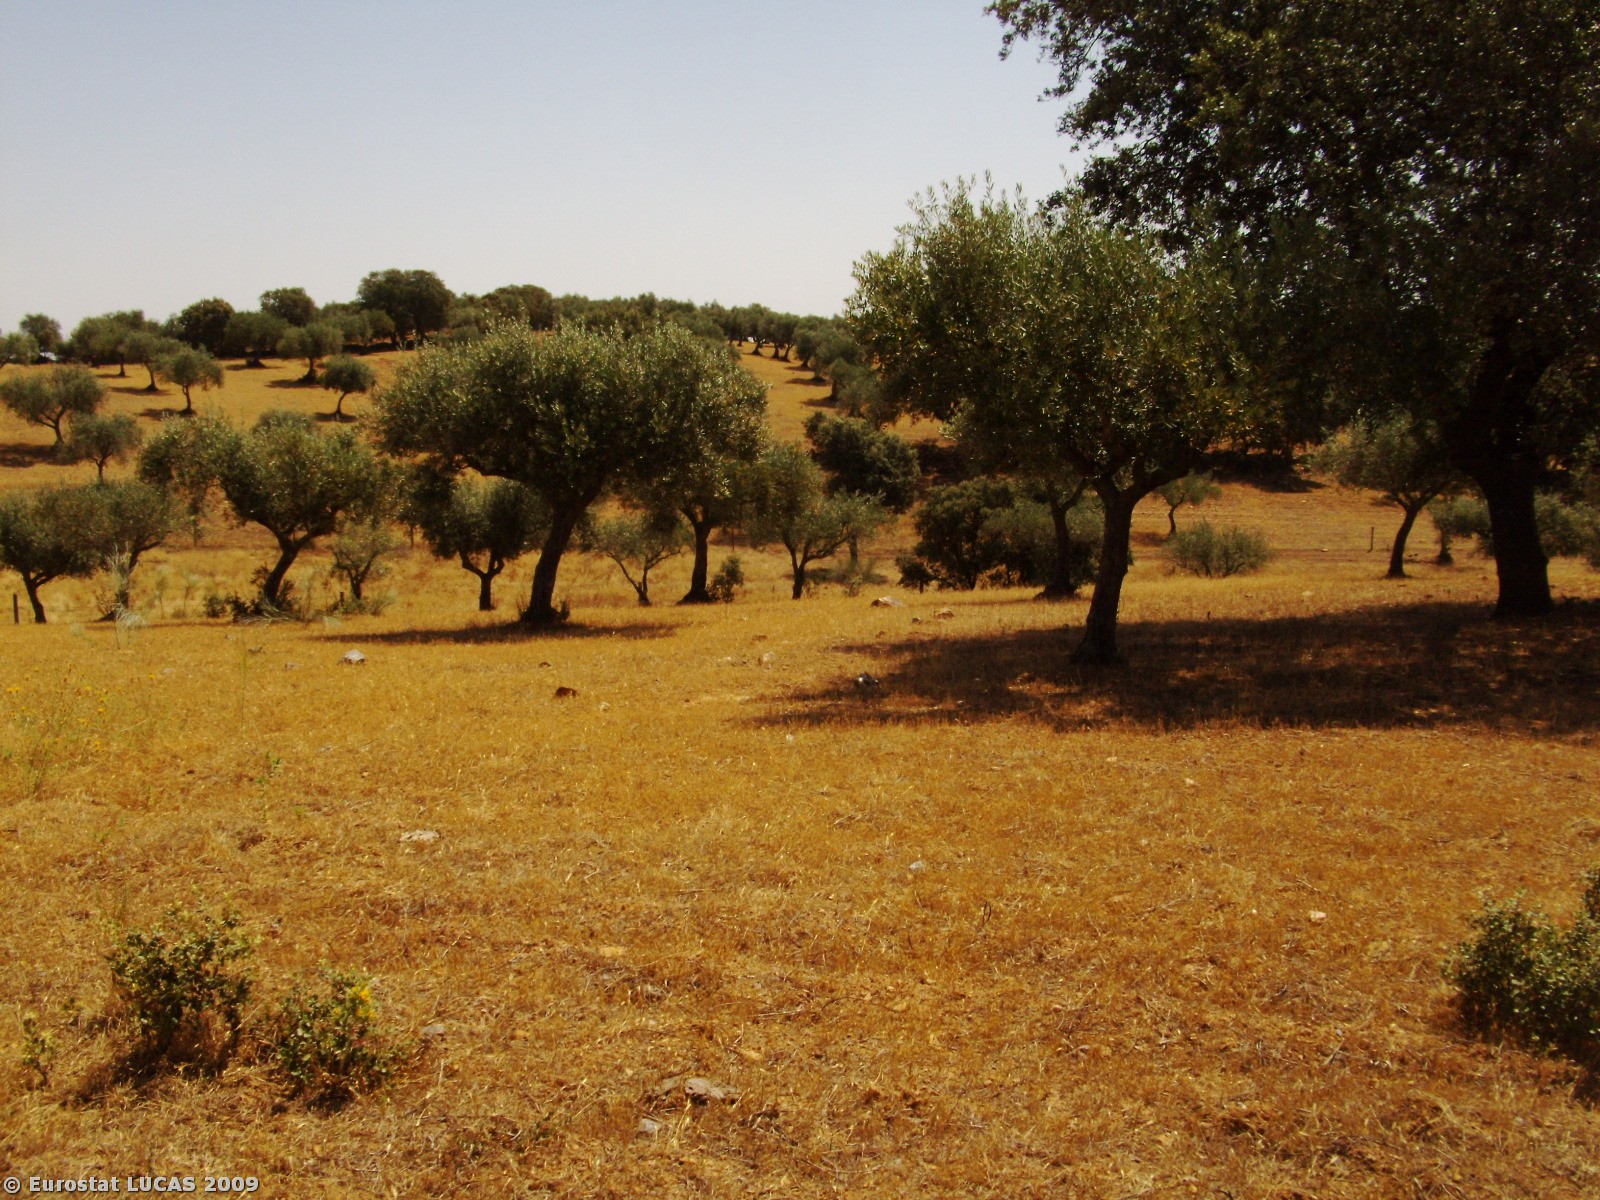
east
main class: Cropland
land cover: Olive groves
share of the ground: 50 - 75 %
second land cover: Spontaneously vegetated surfaces
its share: 10 - 25 %
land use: Agriculture (excluding fallow land and kitchen gardens)
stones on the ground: > 50 %
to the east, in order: Olive groves; Spontaneously vegetated surfaces; Olive groves; Fences; Spontaneously vegetated surfaces; Fences; Olive groves; Broadleaved woodland; Olive groves
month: June
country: PT
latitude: 39.8252
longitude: -7.0890
